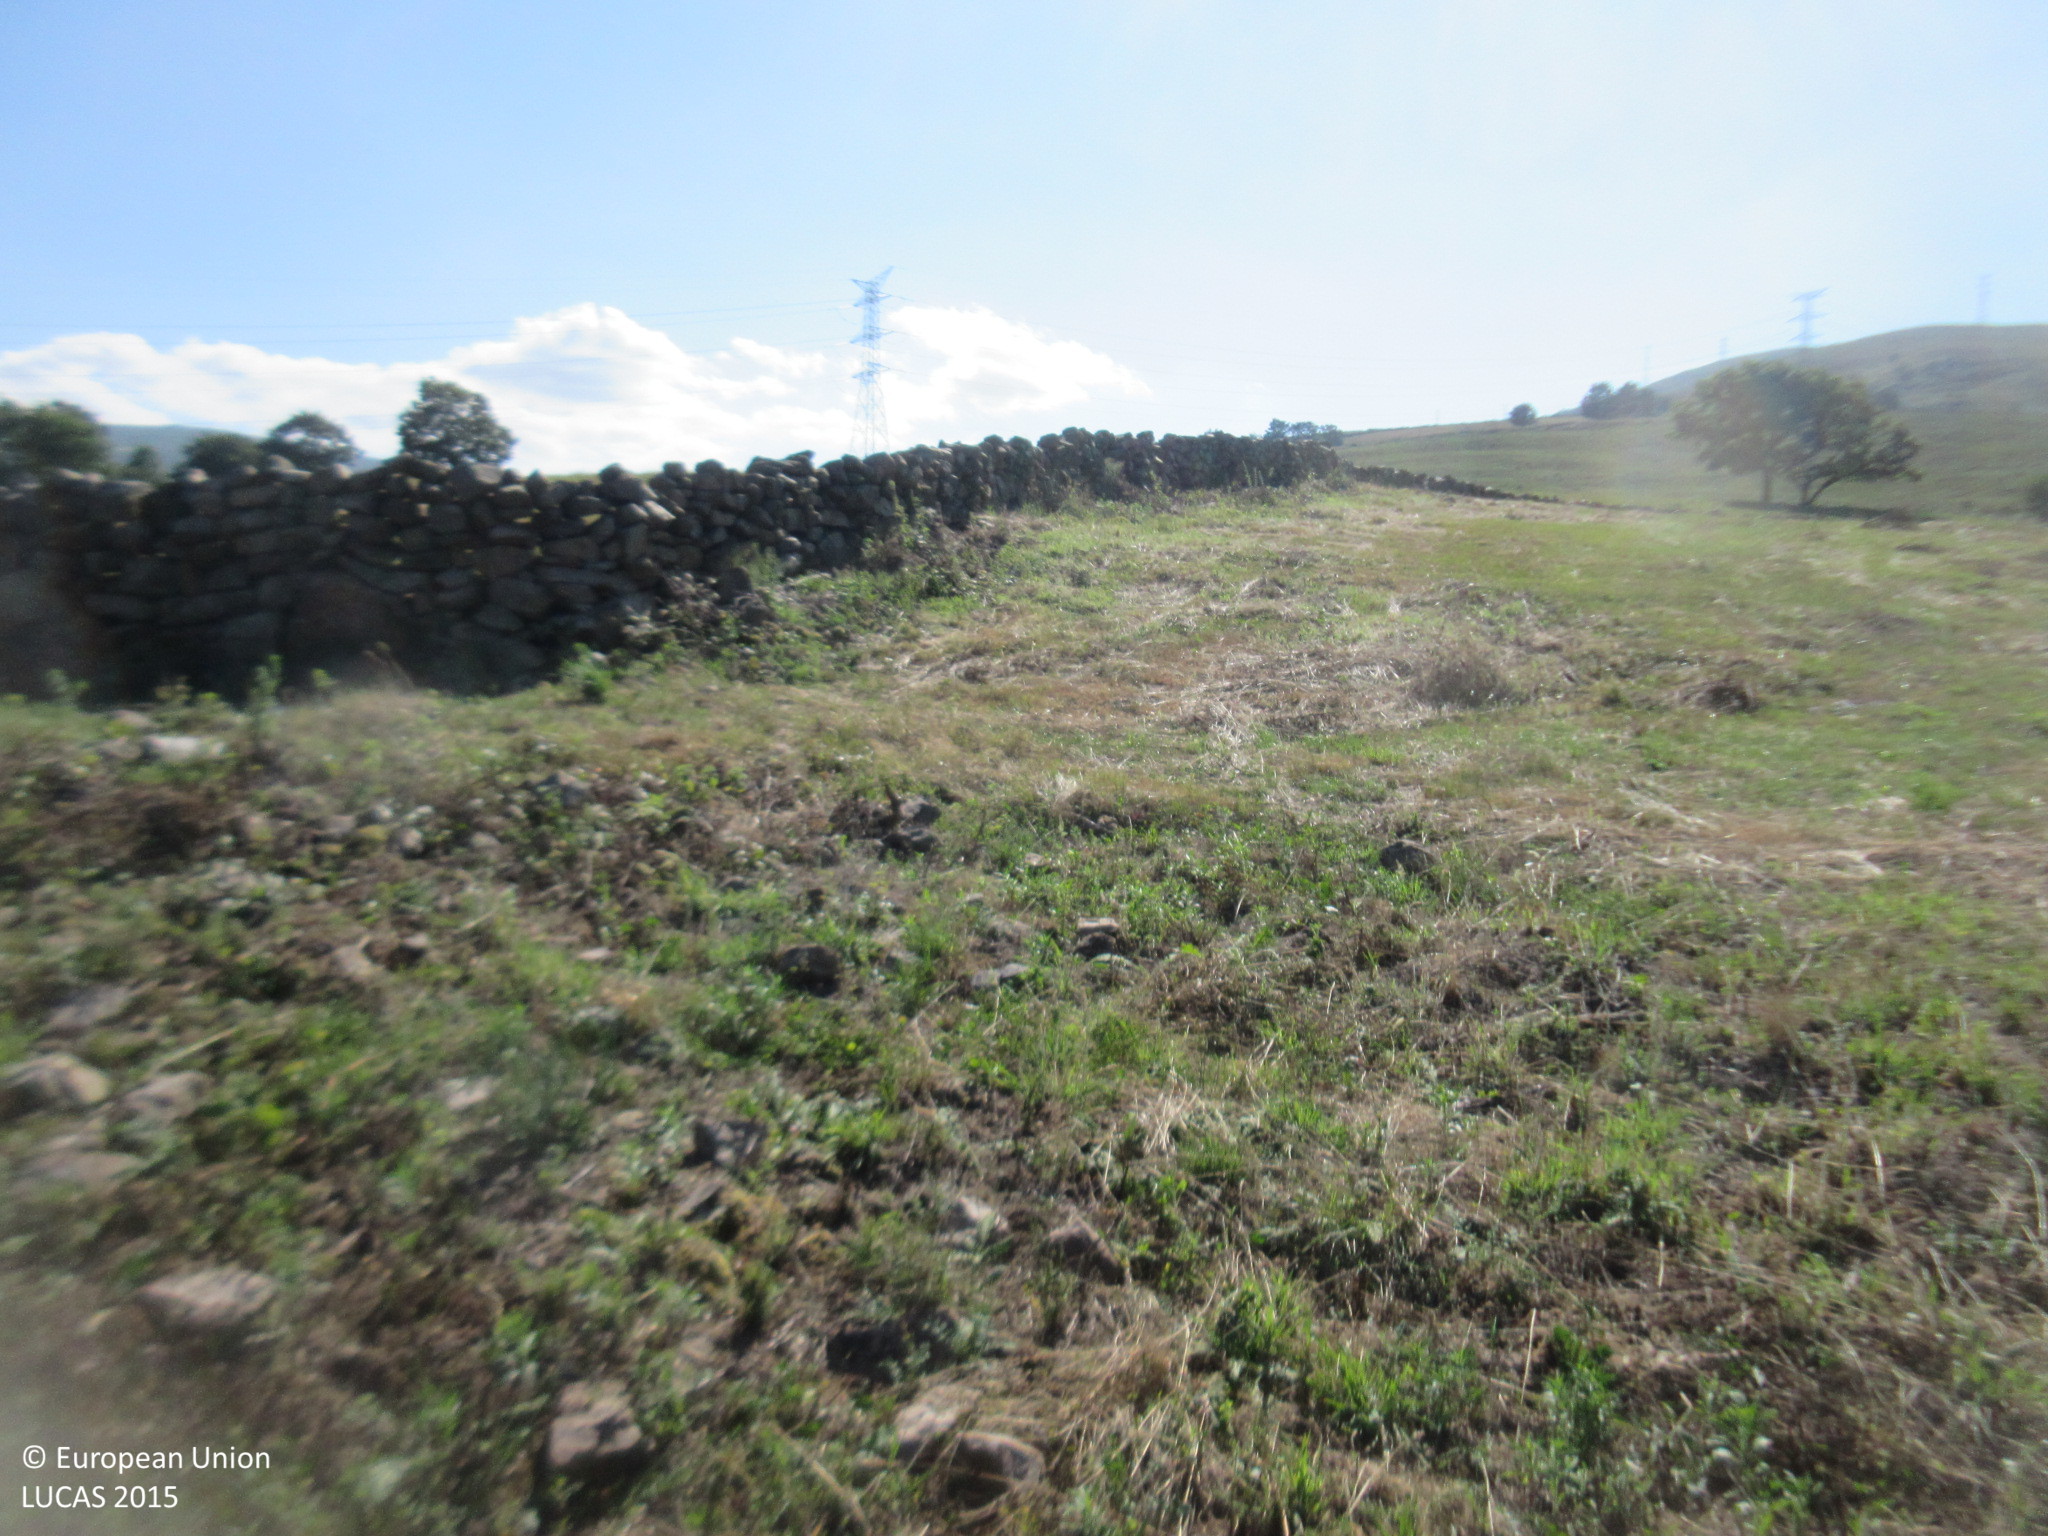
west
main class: Grassland
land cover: Grassland without tree/shrub cover
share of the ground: > 75 %
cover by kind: herbaceous plants 100 %
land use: Agriculture (excluding fallow land and kitchen gardens)
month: July
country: ES
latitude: 43.1529
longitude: -3.9068
